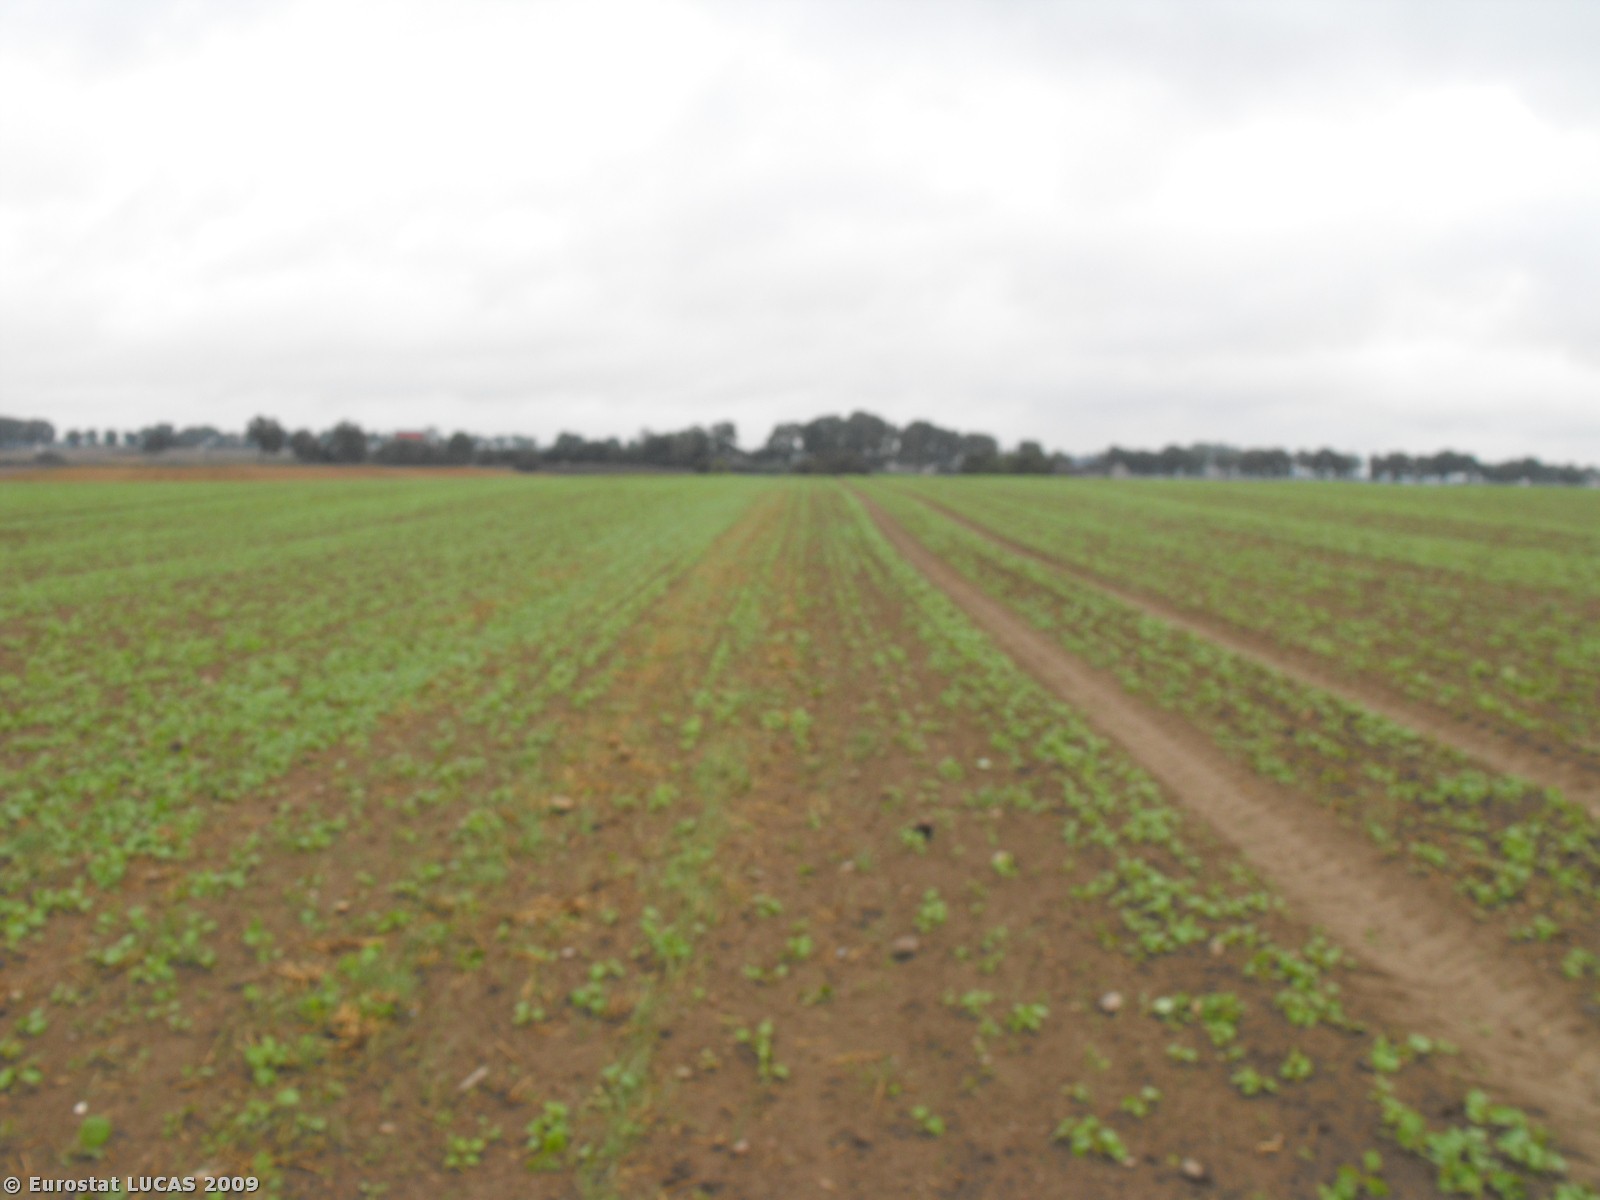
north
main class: Cropland
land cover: Triticale
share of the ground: < 10 %
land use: Agriculture (excluding fallow land and kitchen gardens)
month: September
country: PL
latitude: 53.4979
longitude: 17.1401
